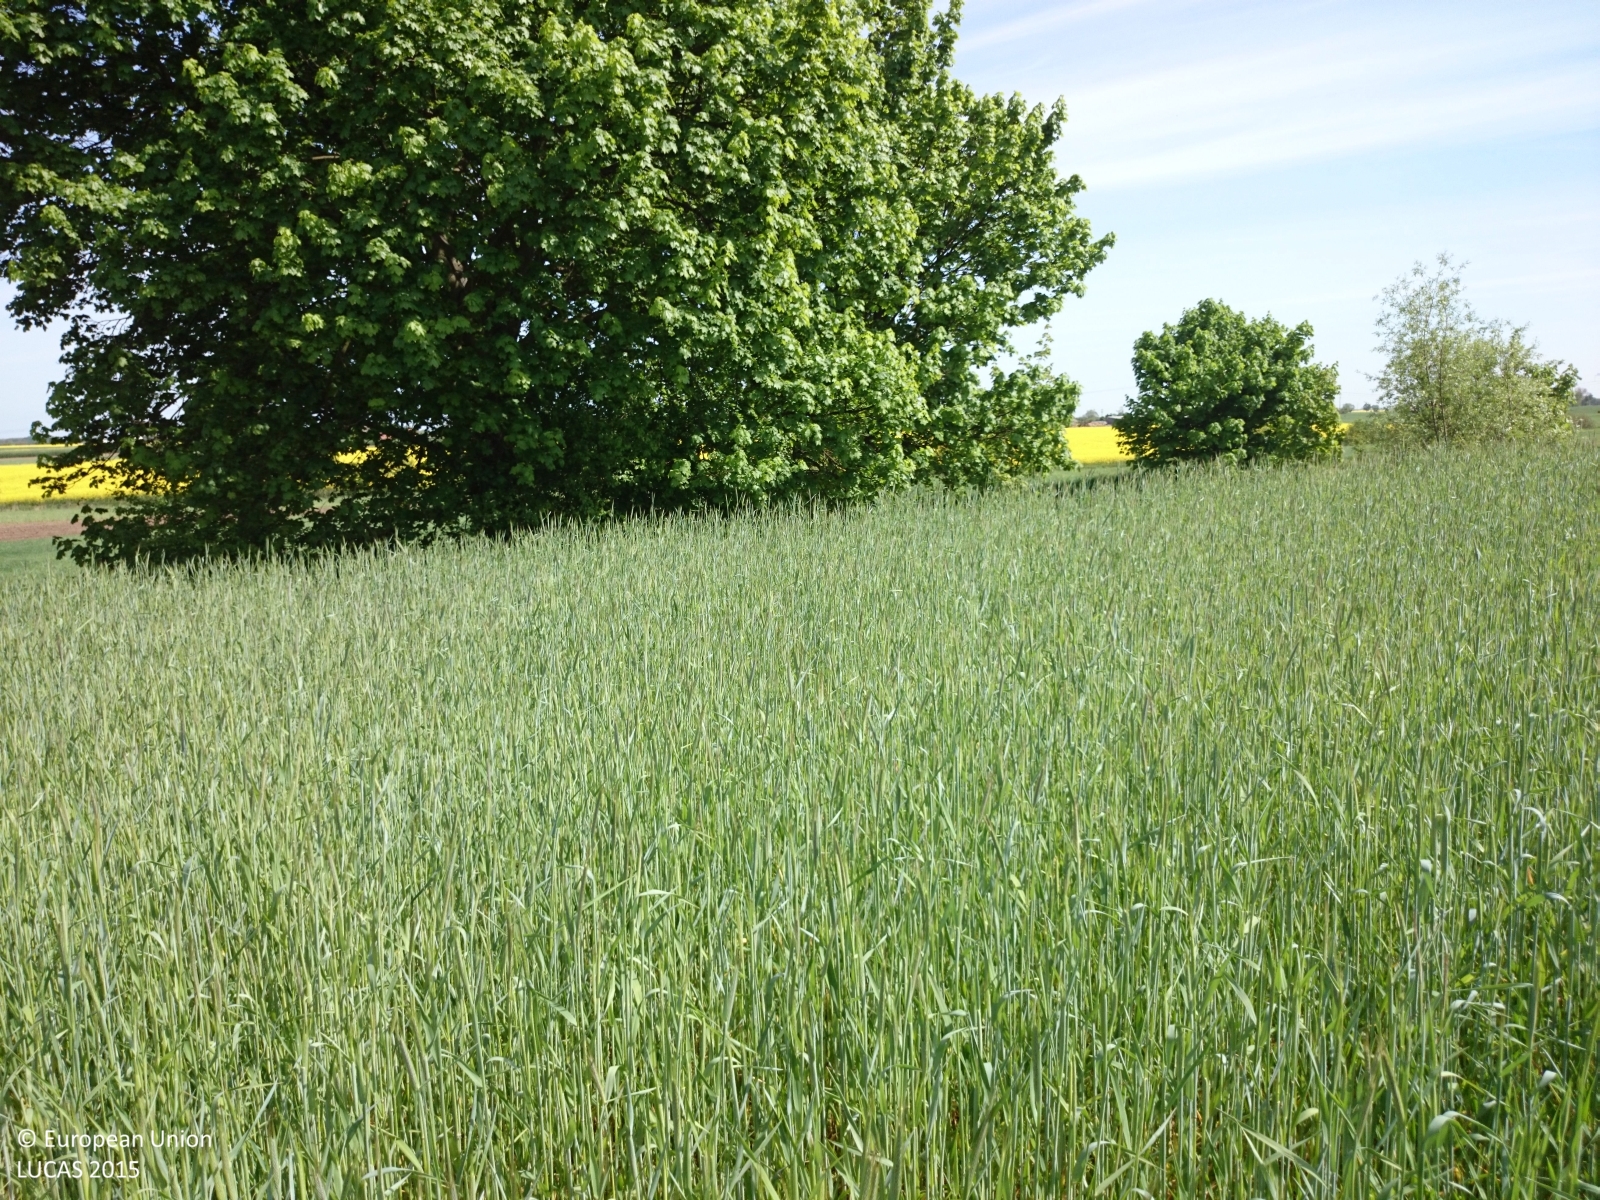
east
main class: Cropland
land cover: Common wheat
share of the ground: > 75 %
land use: Agriculture (excluding fallow land and kitchen gardens)
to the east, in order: Common wheat; Grass margins; Lines of trees; Grass margins; Tracks; Spontaneously vegetated surfaces; Common wheat
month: May
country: PL
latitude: 52.4452
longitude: 16.2889
